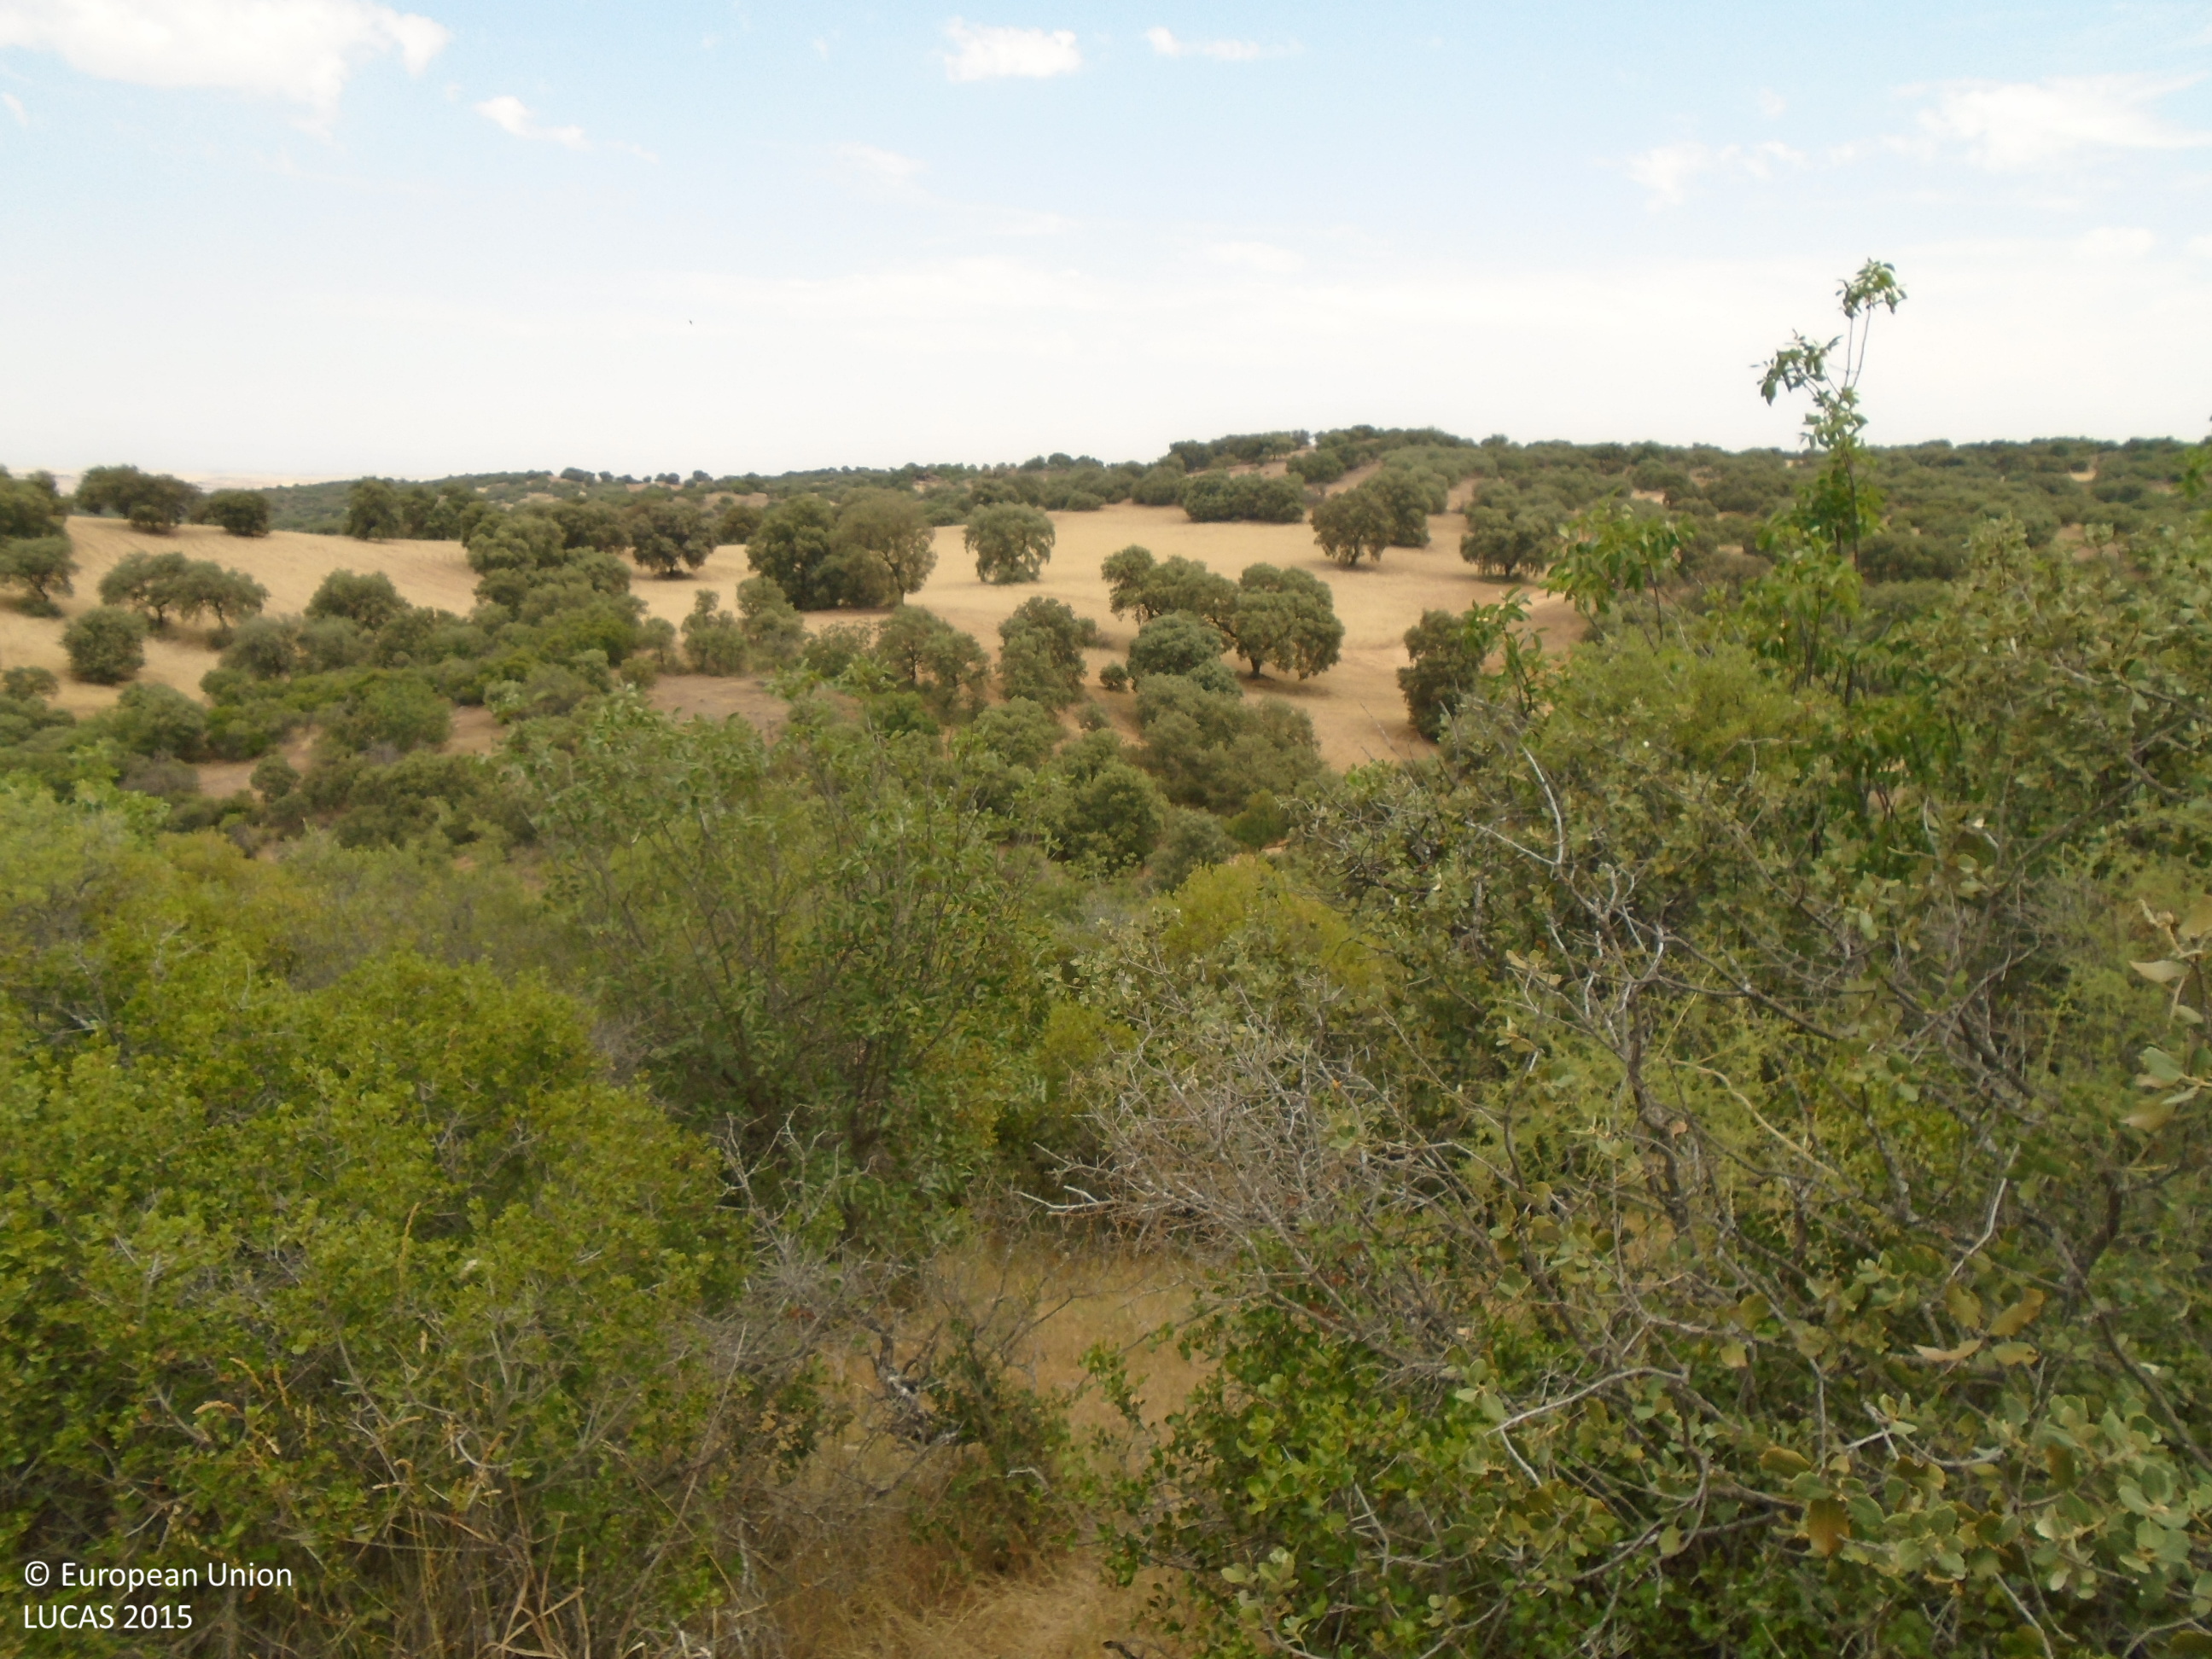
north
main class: Shrubland
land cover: Shrubland without tree cover
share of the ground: > 75 %
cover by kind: shrubs 95 %, herbaceous plants 5 %
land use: Other primary production
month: June
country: ES
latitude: 39.8180
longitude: -4.1833
